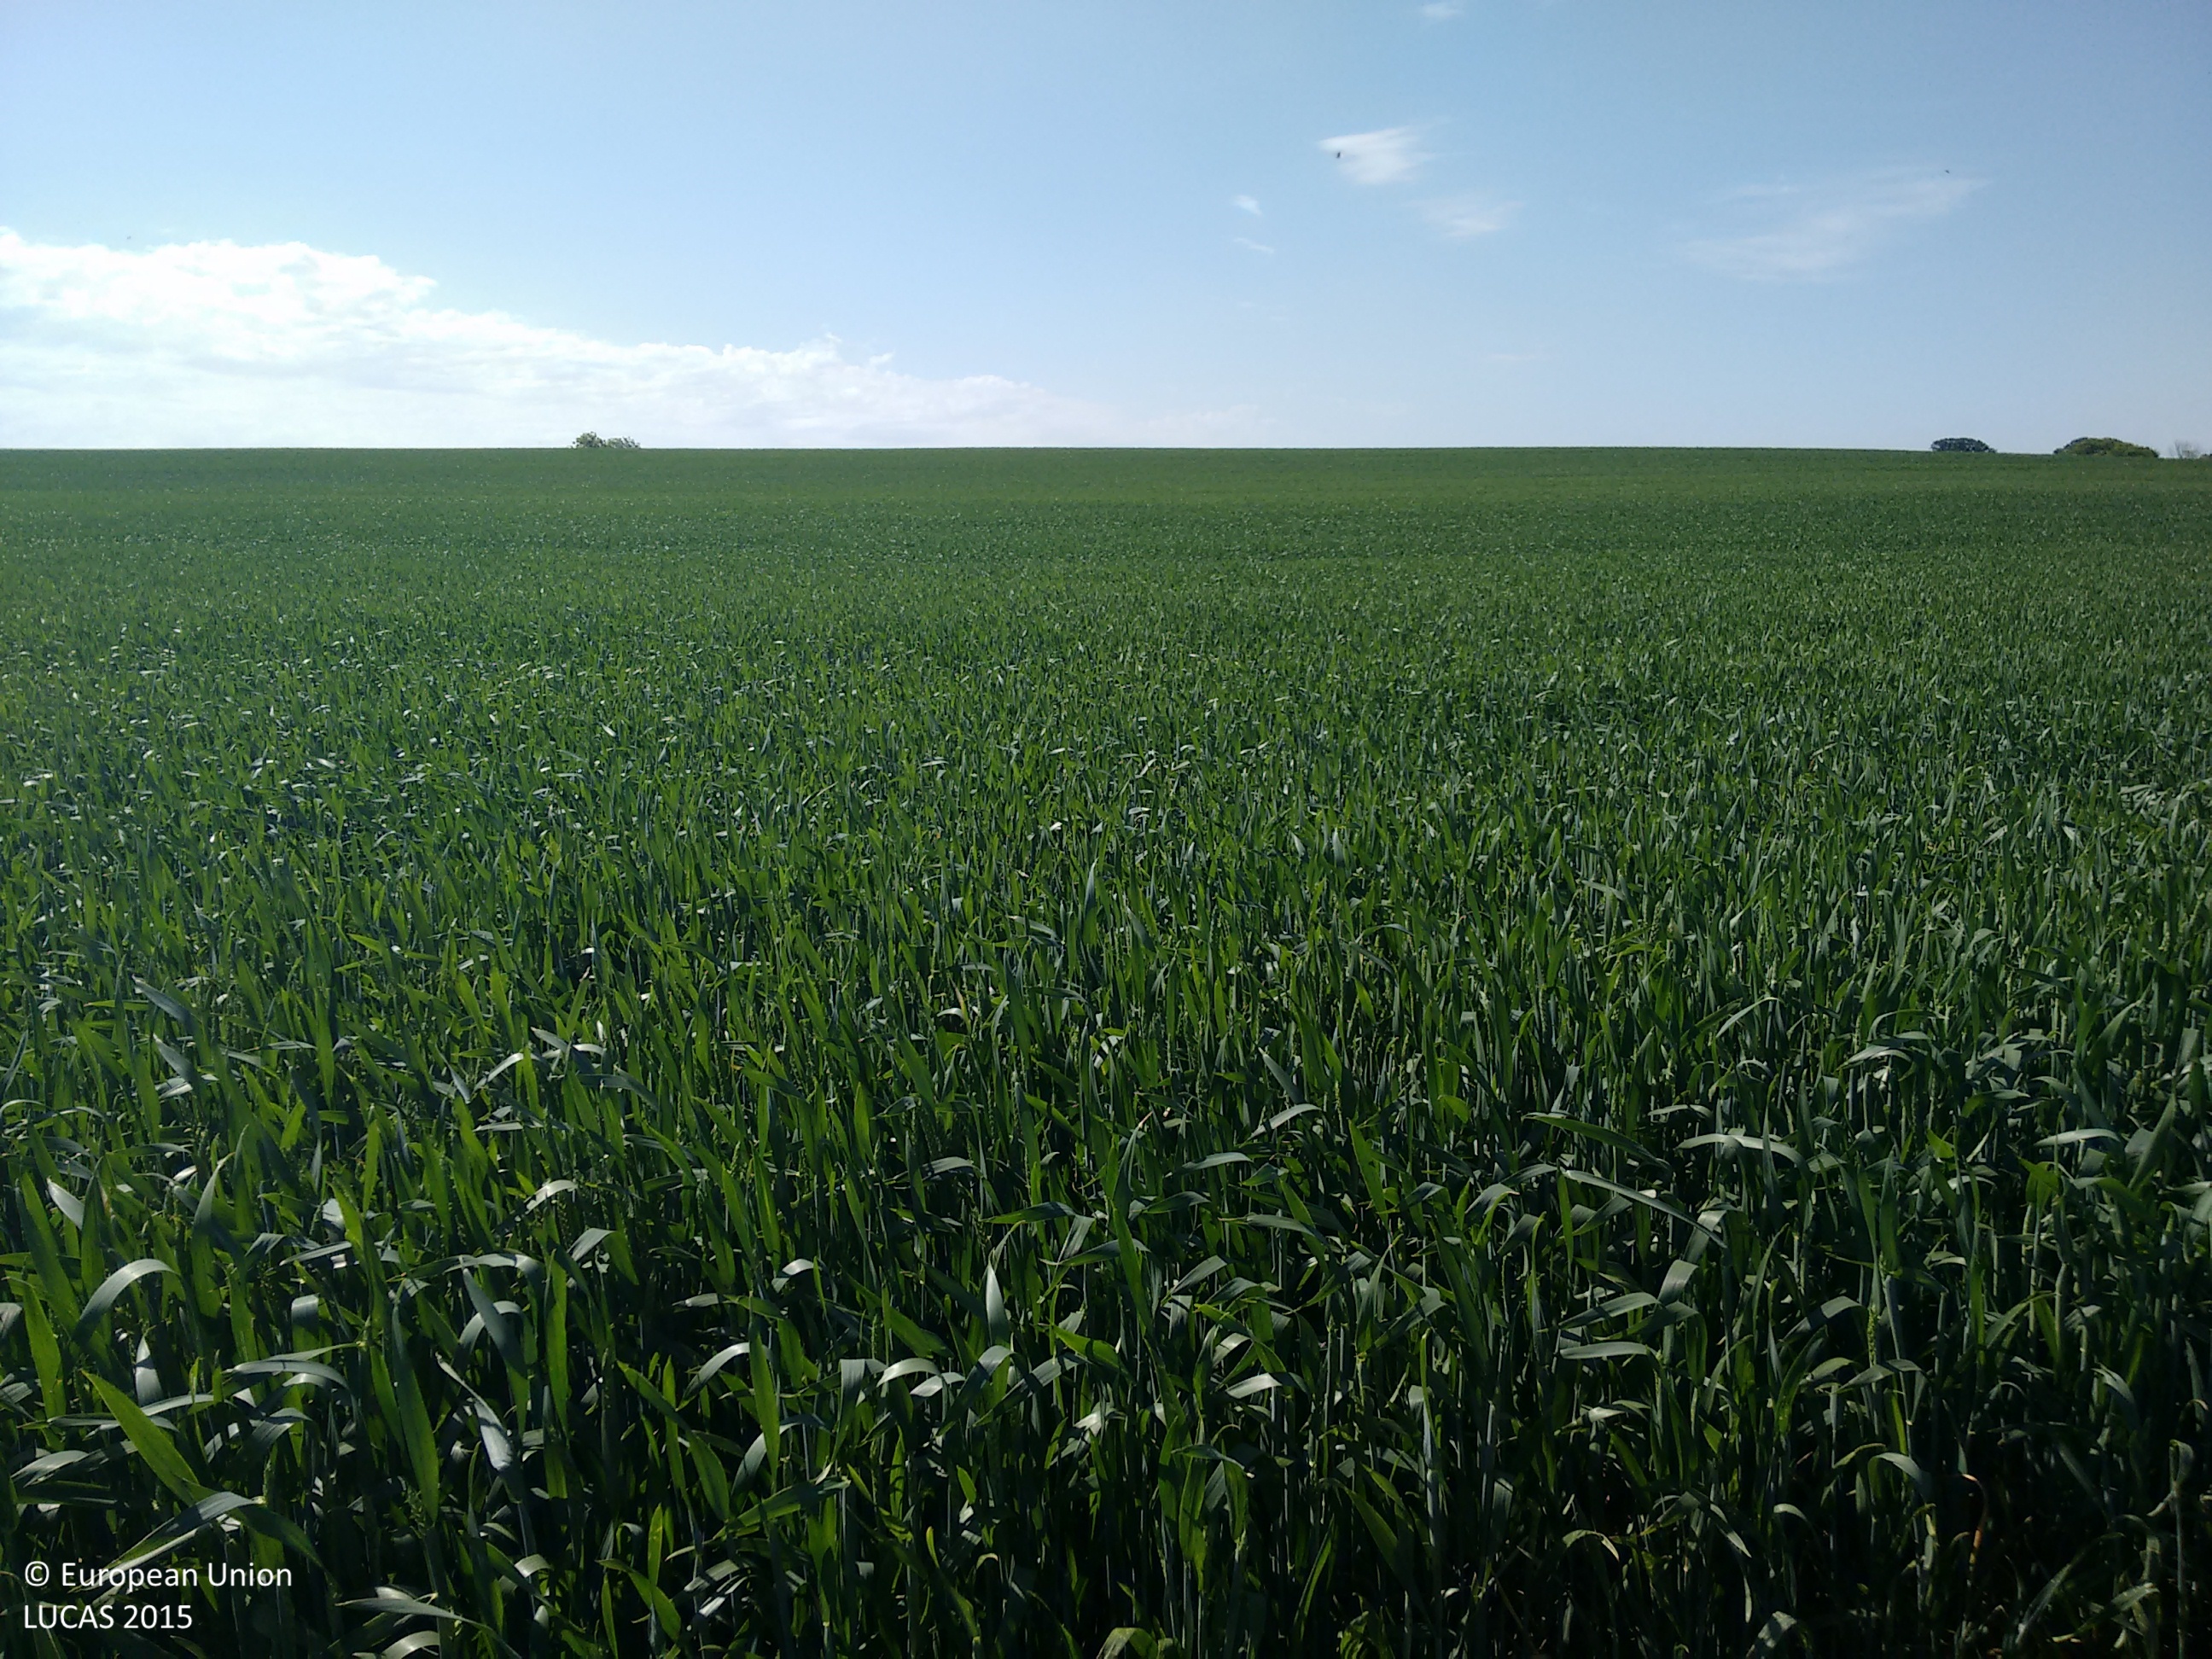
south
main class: Cropland
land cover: Common wheat
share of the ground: > 75 %
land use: Agriculture (excluding fallow land and kitchen gardens)
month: June
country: GB
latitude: 50.8706
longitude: -2.3845
